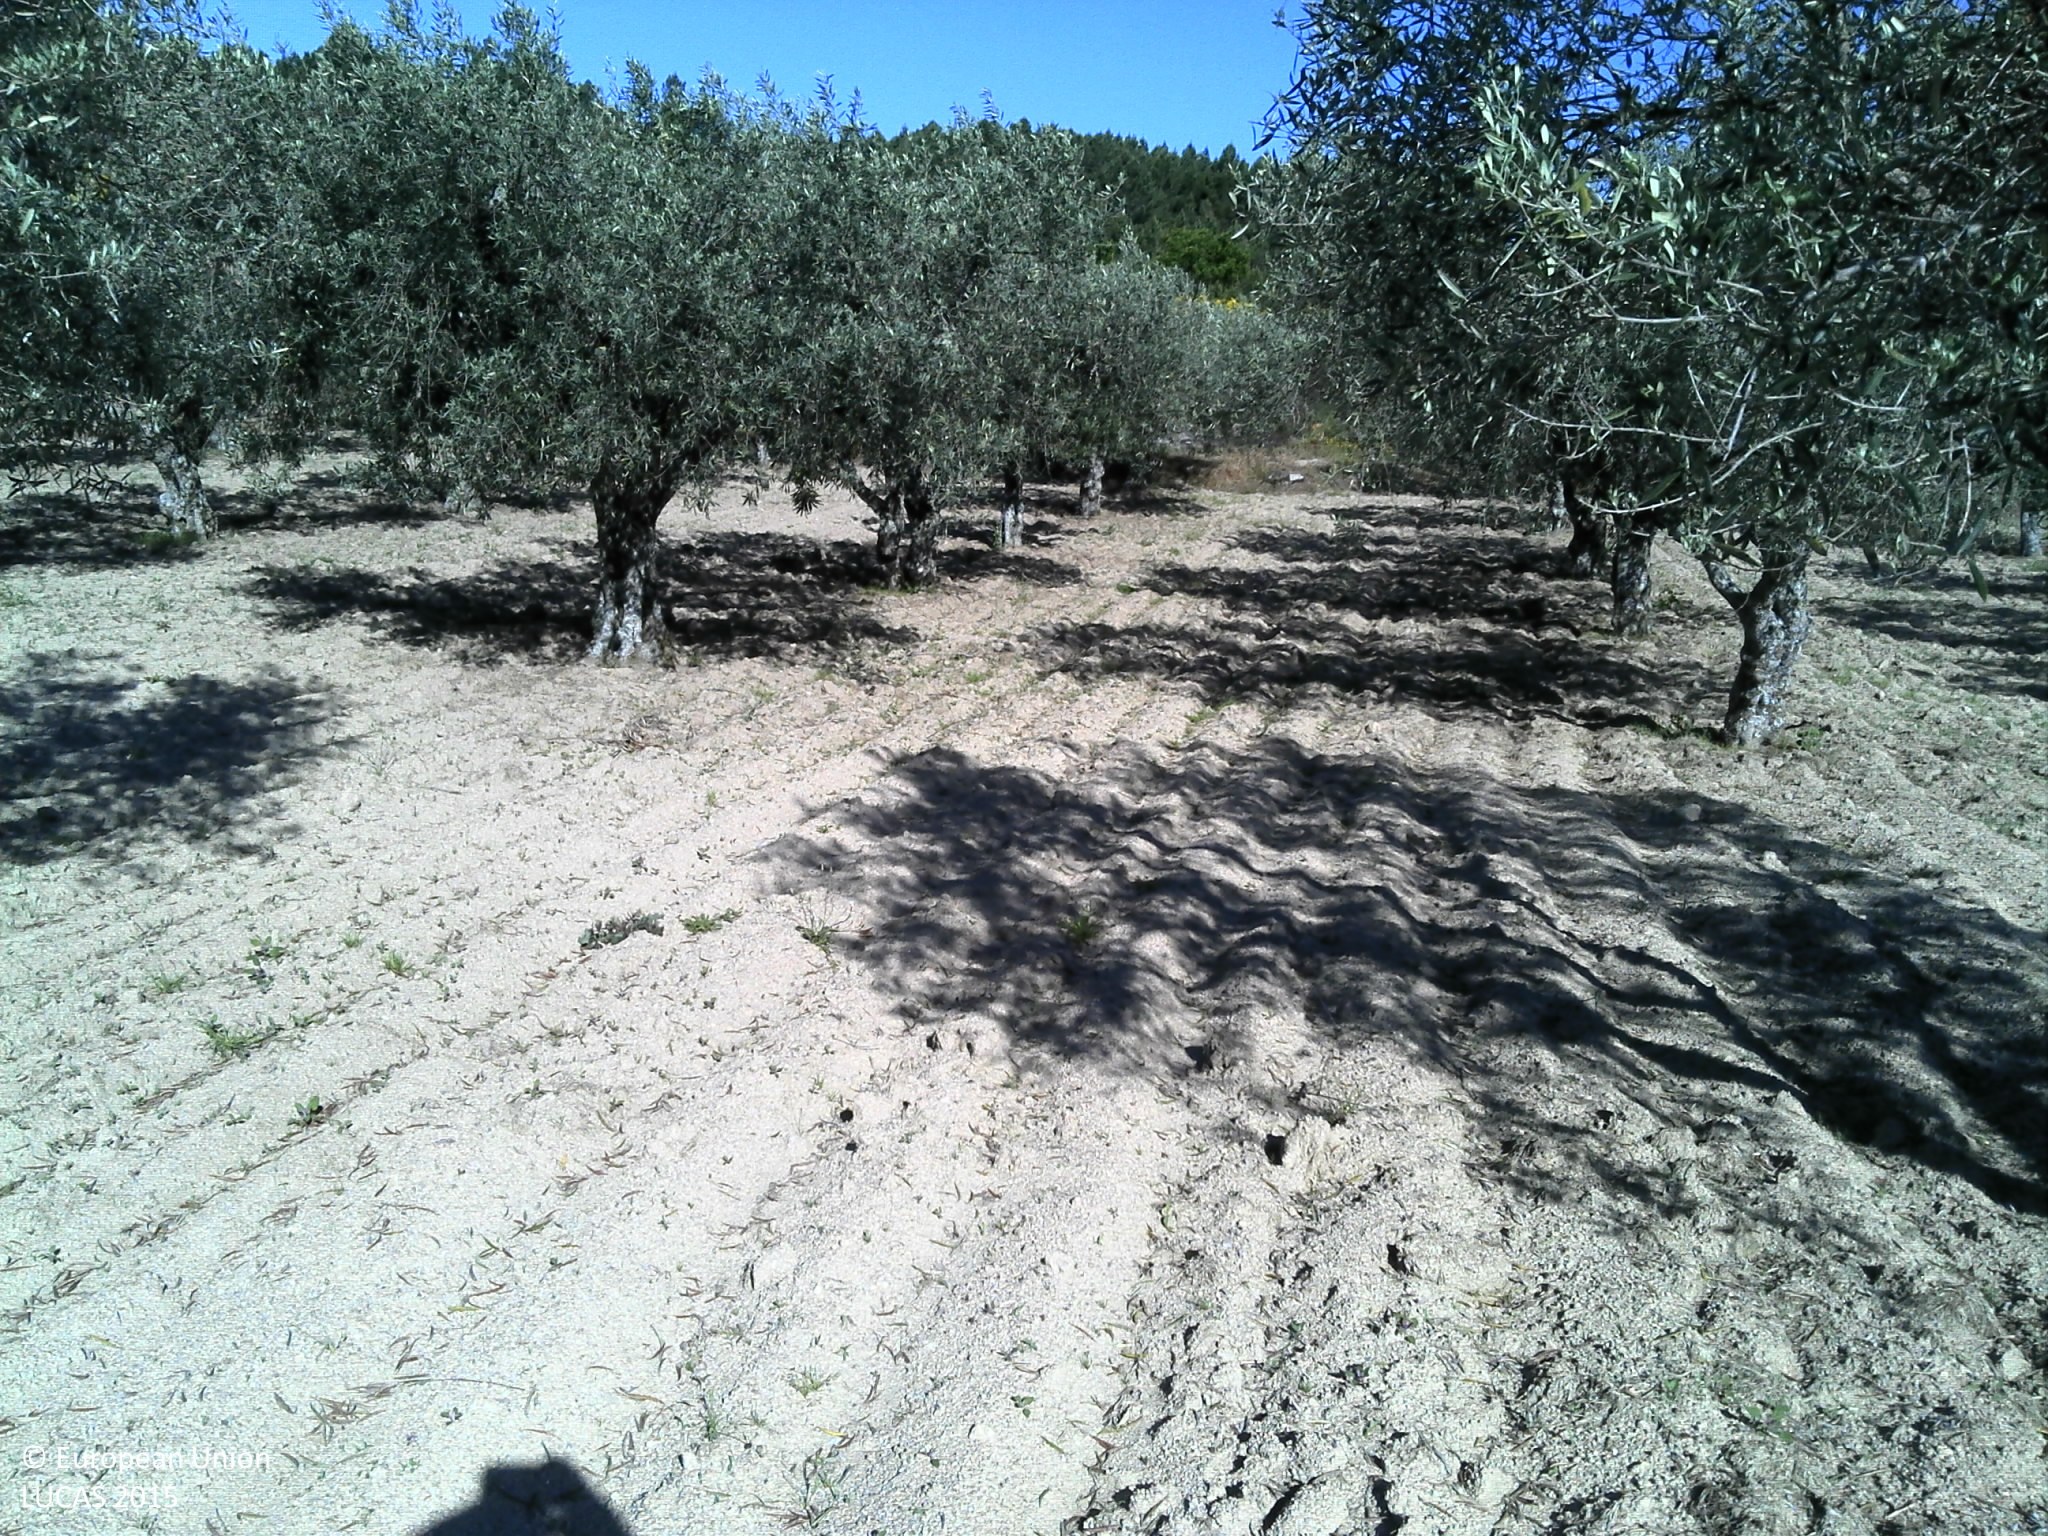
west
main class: Cropland
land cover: Olive groves
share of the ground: 25 - 50 %
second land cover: Other bare soil
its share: > 75 %
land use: Agriculture (excluding fallow land and kitchen gardens)
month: May
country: PT
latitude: 41.7257
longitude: -7.1807
